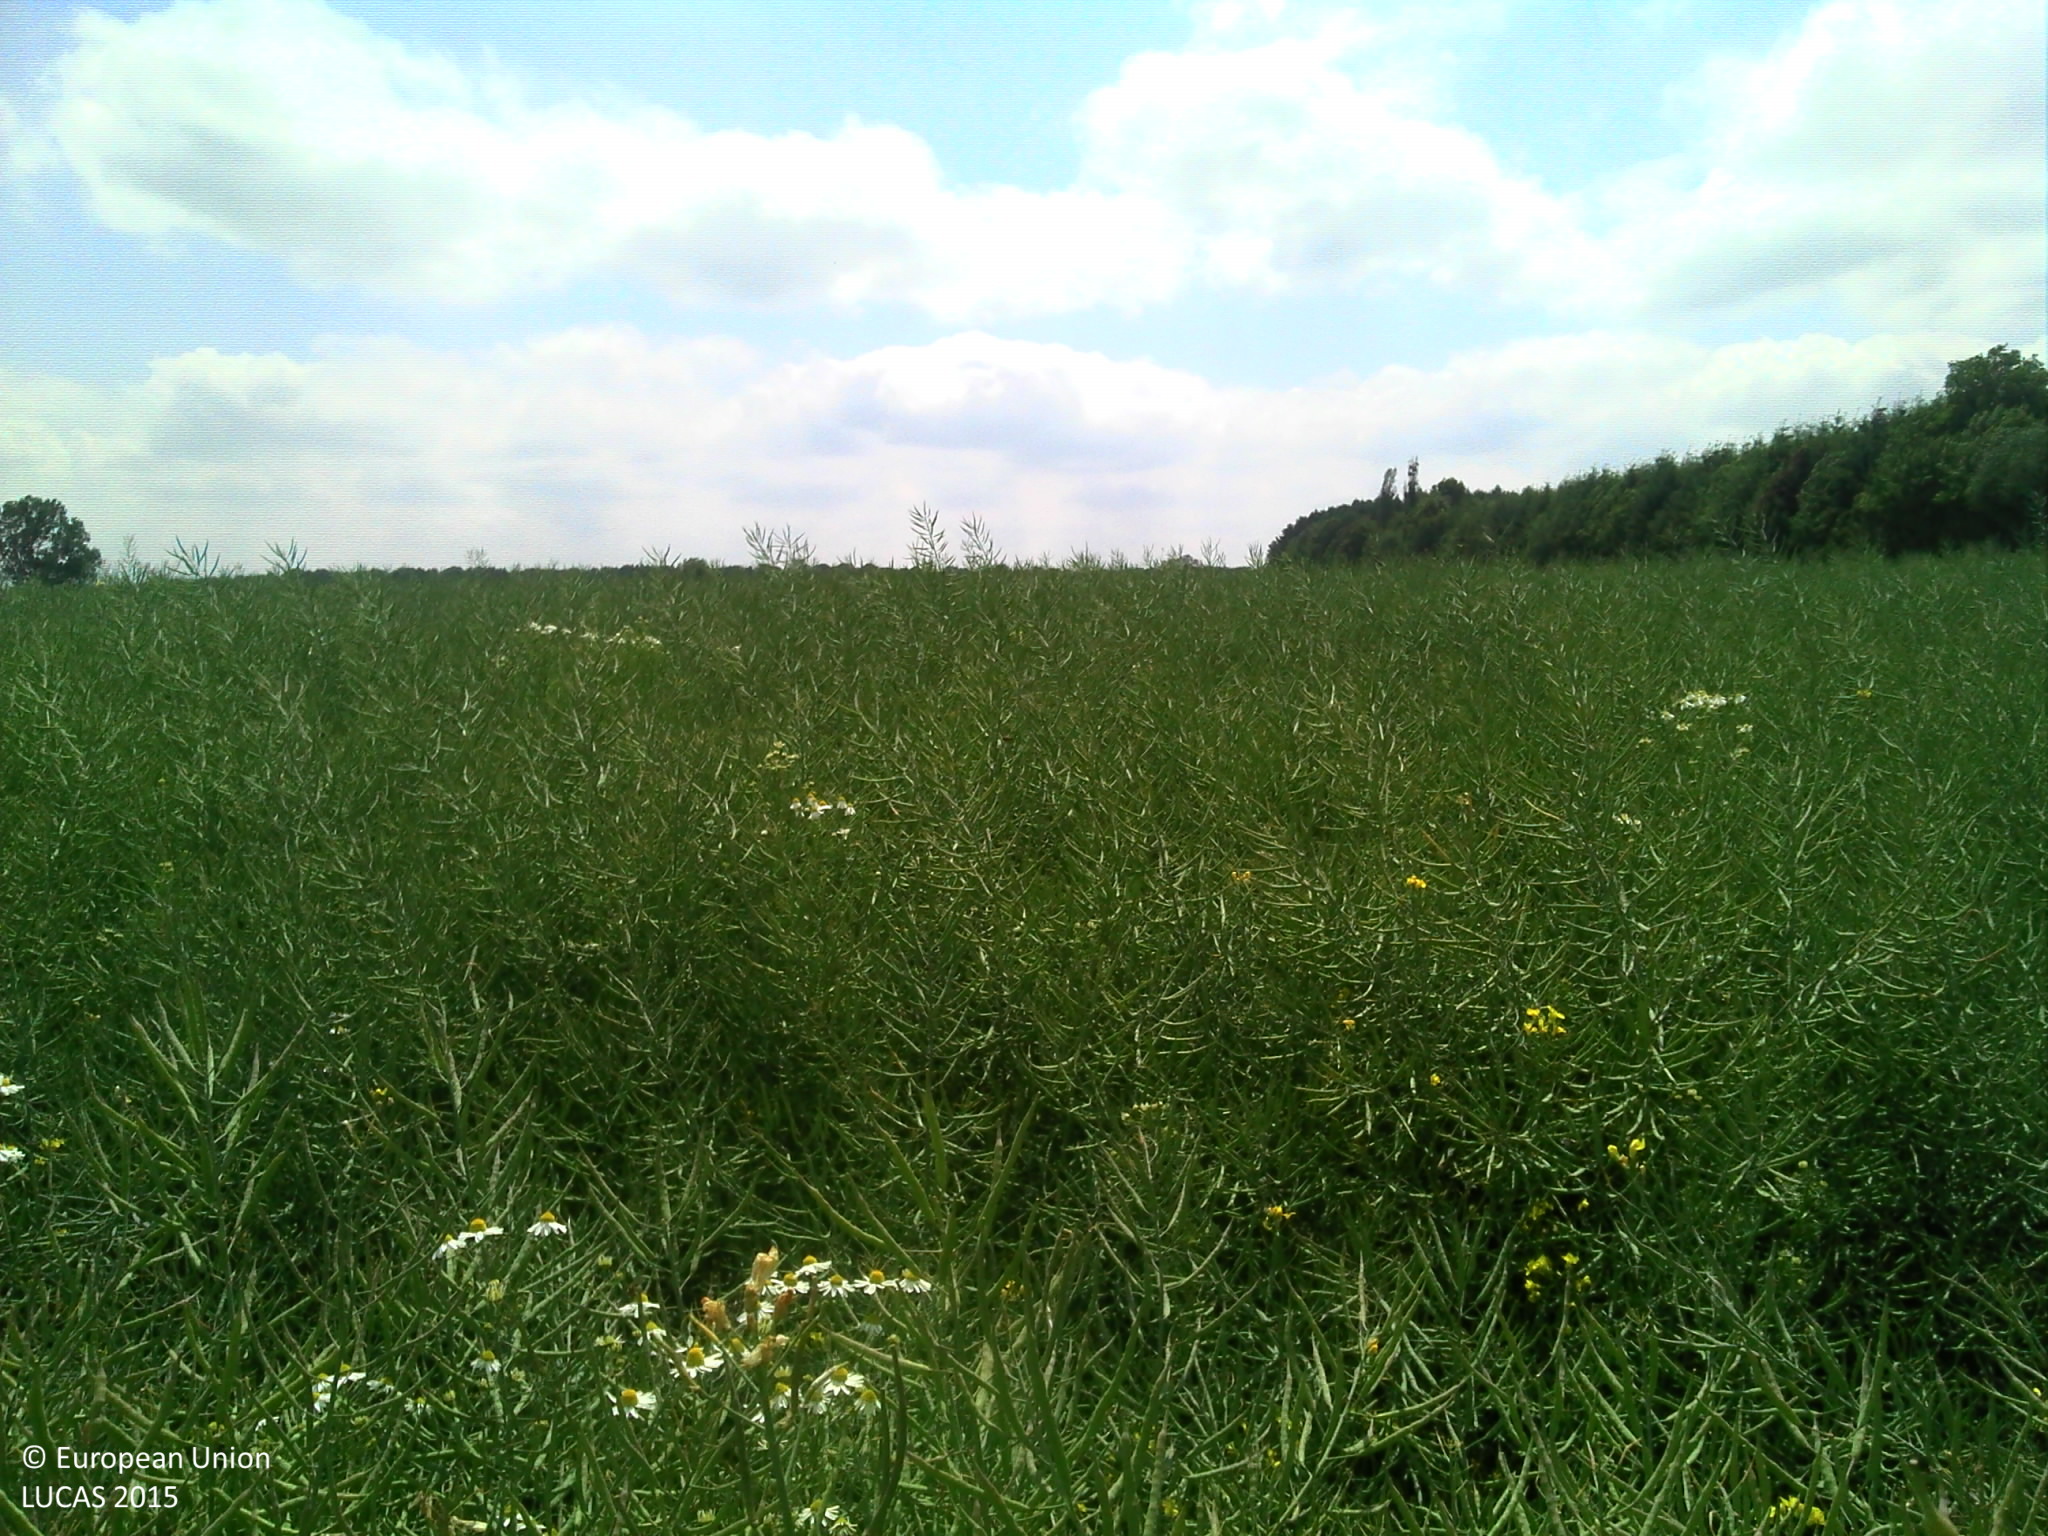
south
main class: Cropland
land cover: Rape and turnip rape
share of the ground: > 75 %
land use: Agriculture (excluding fallow land and kitchen gardens)
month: June
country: BE
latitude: 50.3646
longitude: 4.6402
